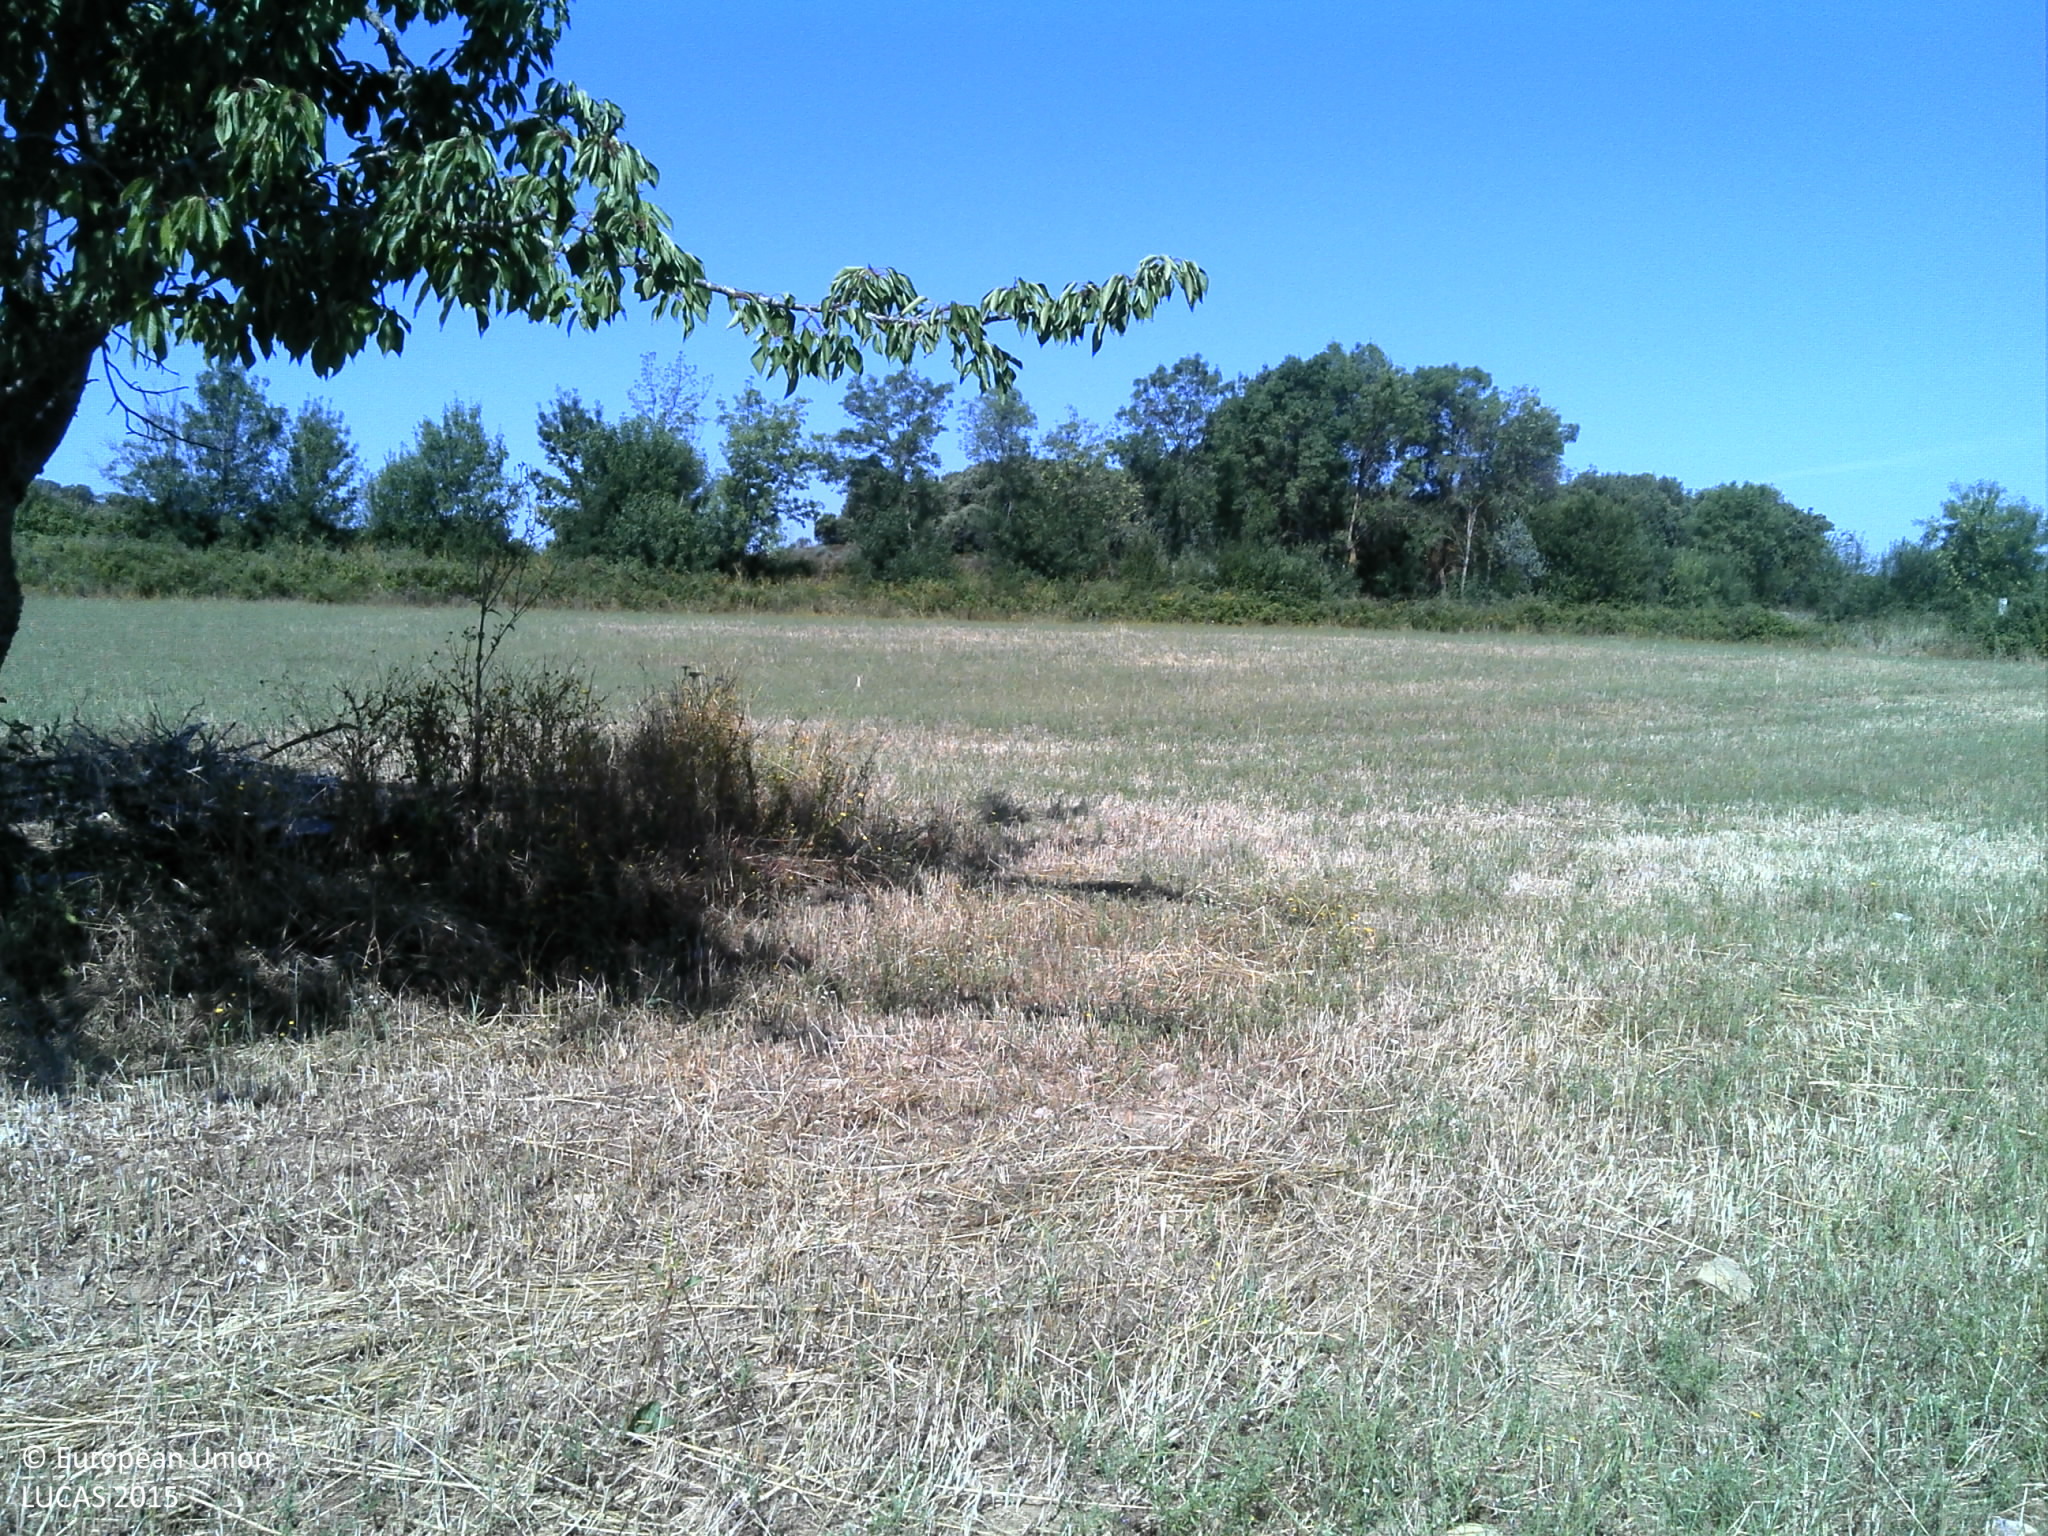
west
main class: Cropland
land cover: Oats
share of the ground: > 75 %
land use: Agriculture (excluding fallow land and kitchen gardens)
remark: Harvested field
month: June
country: PT
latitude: 40.8801
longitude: -7.0645
